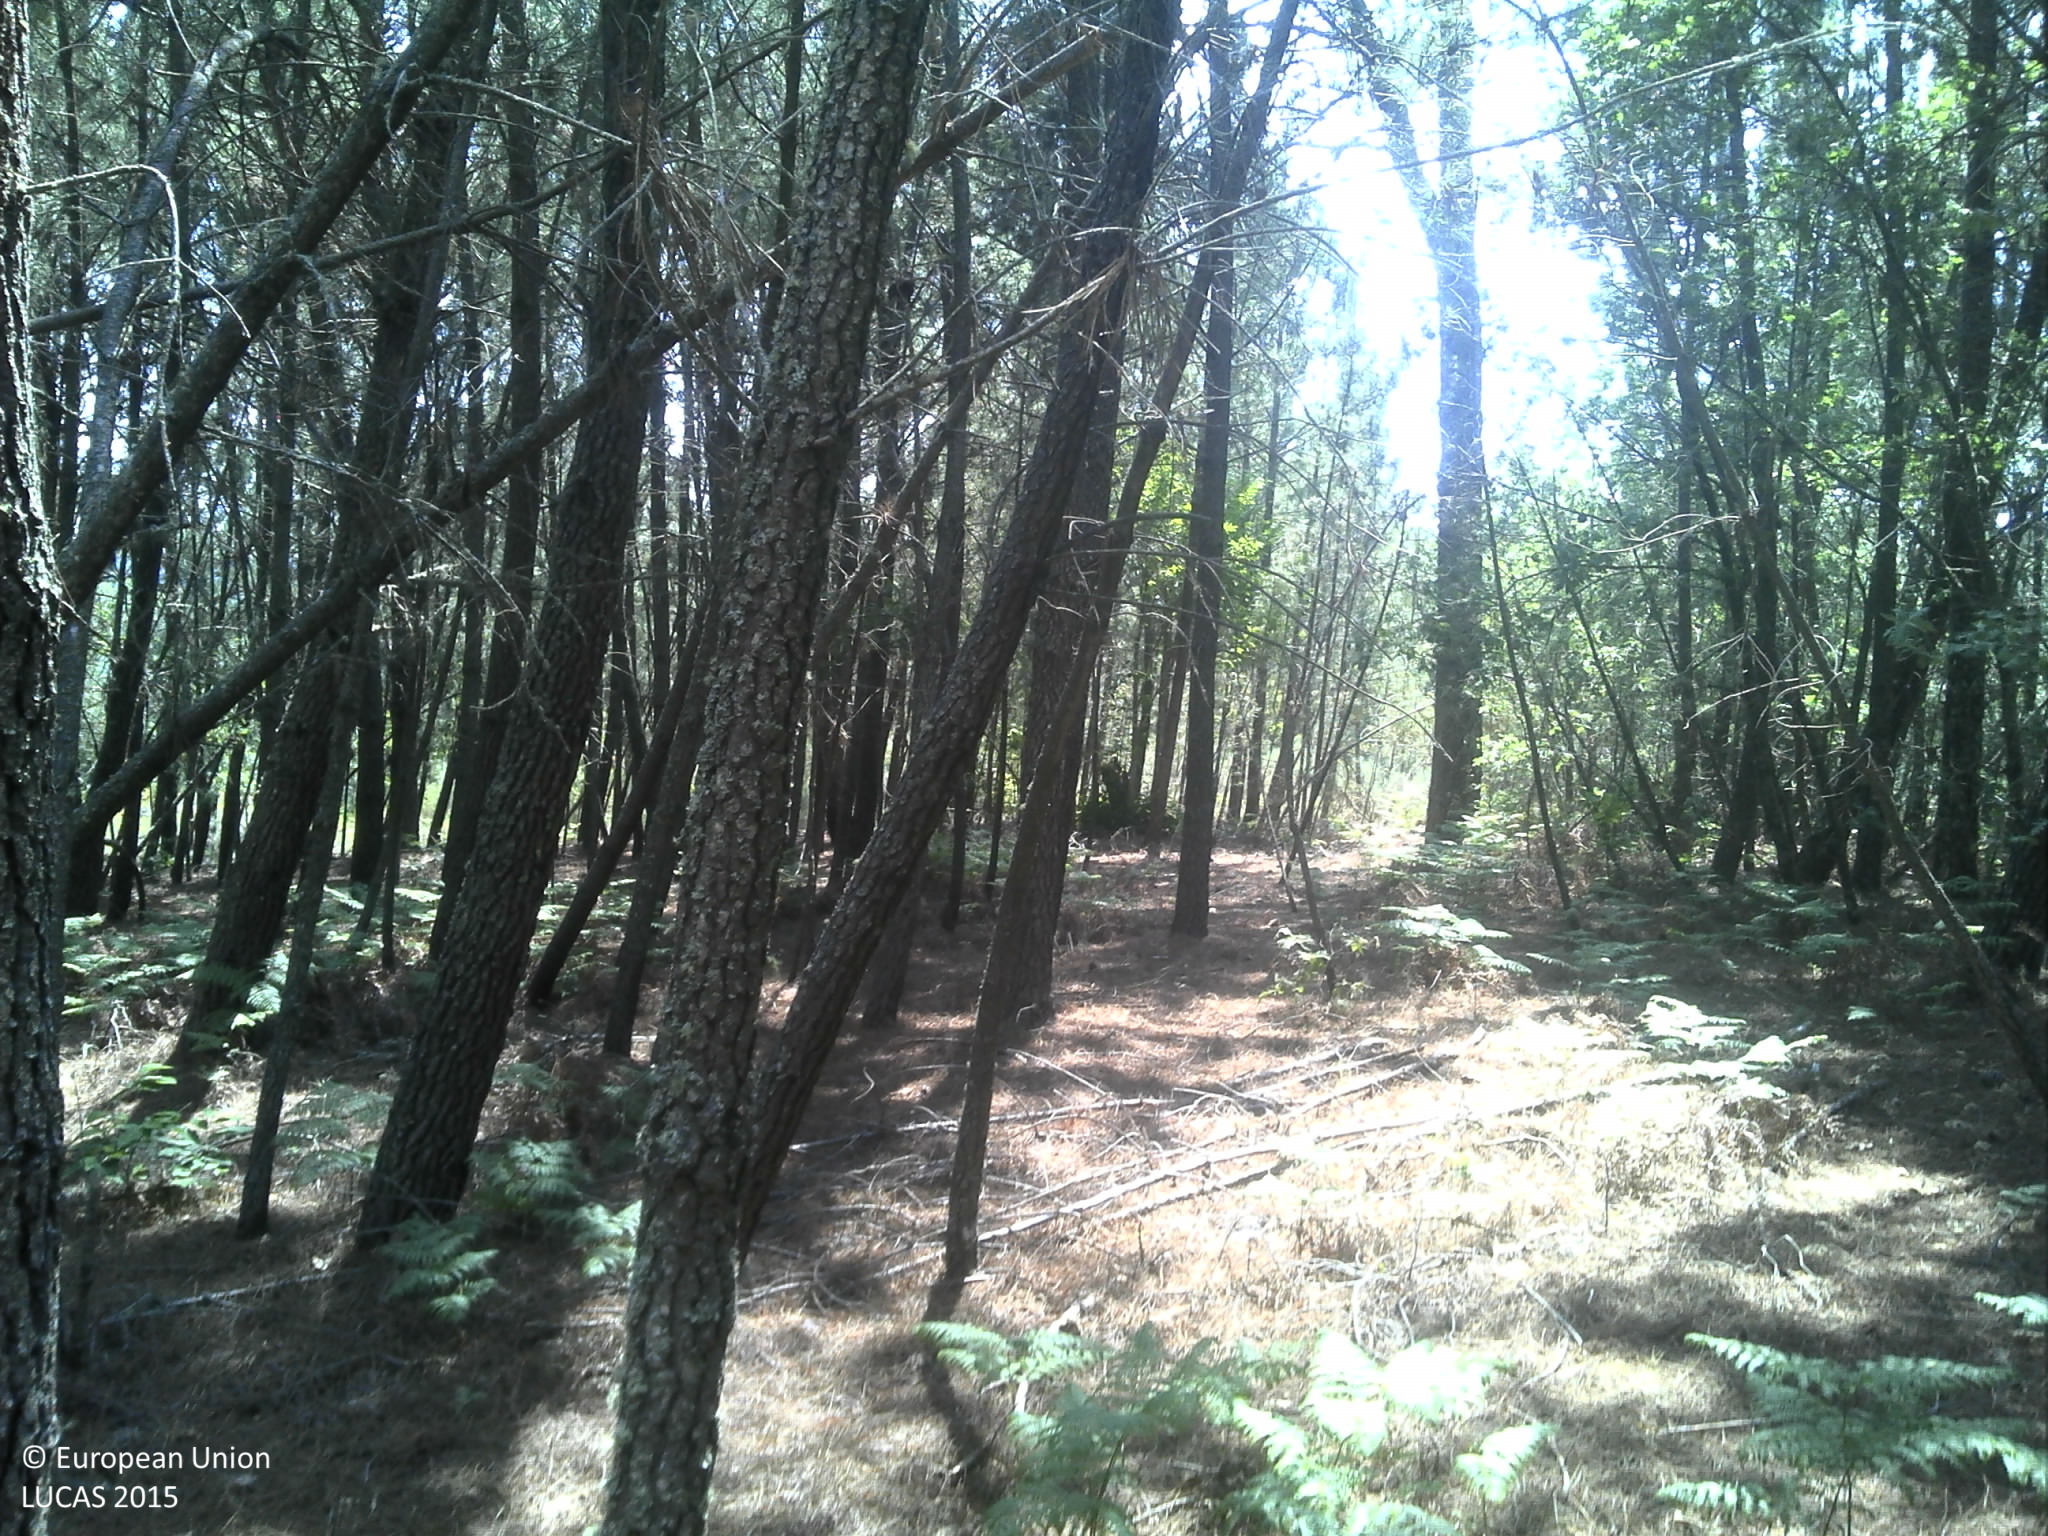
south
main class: Woodland
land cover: Pine dominated coniferous woodland
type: coniferous forest of the mediterranean region
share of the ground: 50 - 75 %
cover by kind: coniferous forest trees 75 %, shrubs 10 %, unconsolidated bare surface 10 %
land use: Forestry
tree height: > 5 m
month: June
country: PT
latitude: 40.3068
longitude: -7.0759
